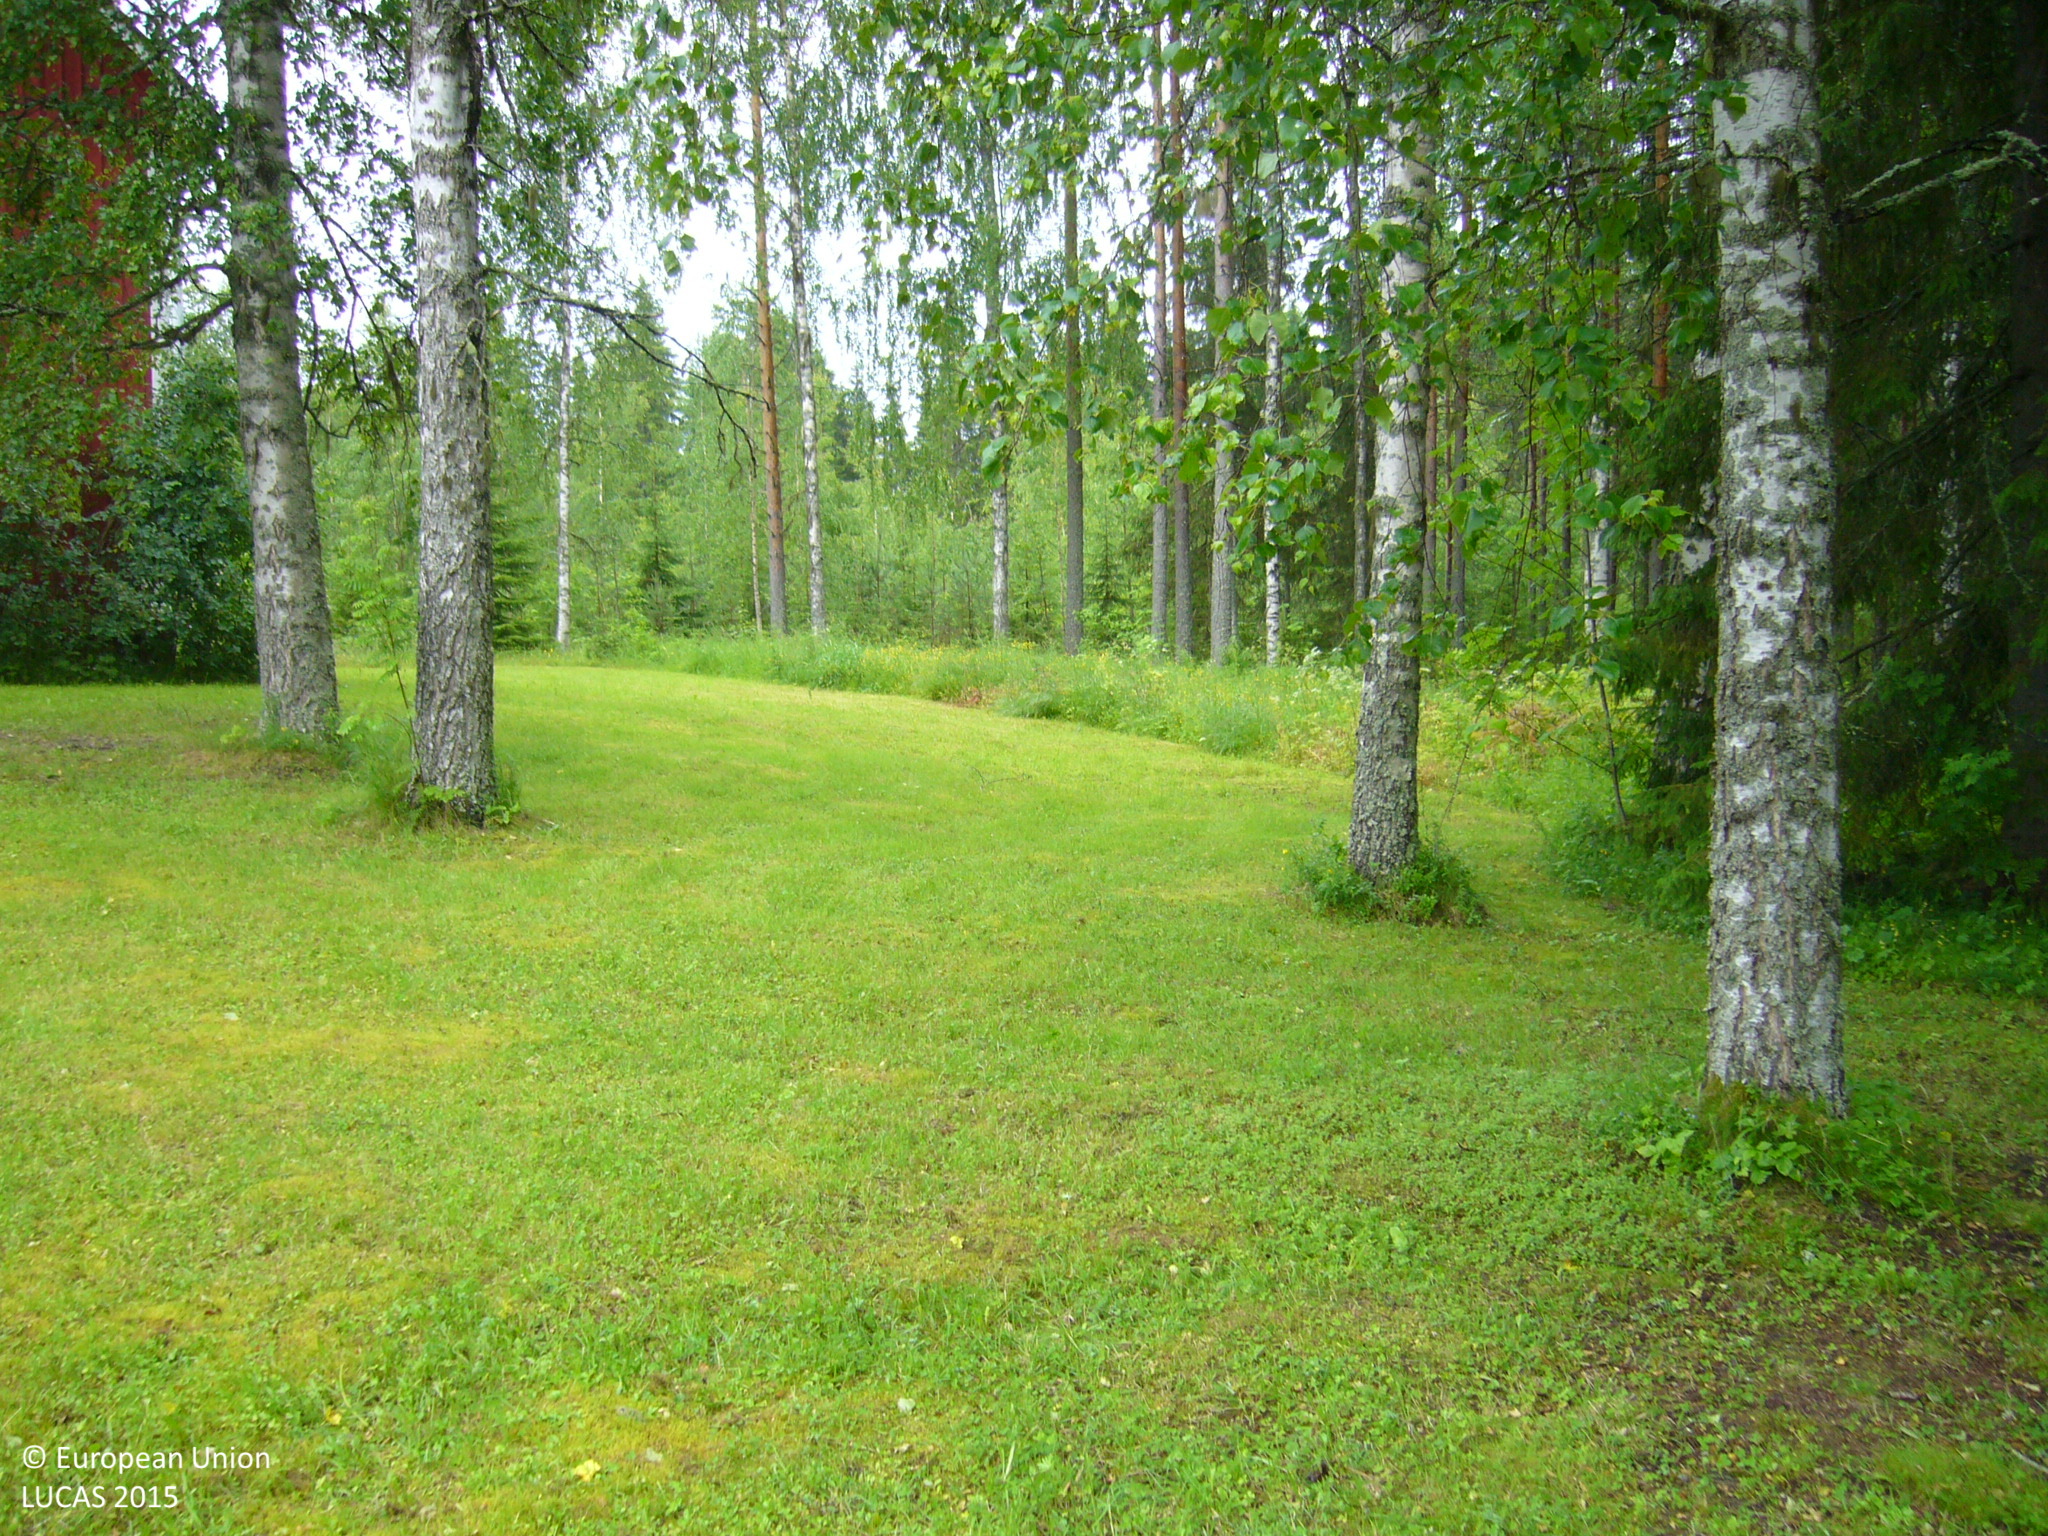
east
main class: Grassland
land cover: Grassland with sparse tree/shrub cover
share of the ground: > 75 %
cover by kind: herbaceous plants 95 %, broadleaved forest trees 5 %
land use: Community services
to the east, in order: Grassland with sparse tree/shrub cover; Spontaneously vegetated surfaces; Pine dominated mixed woodland; Electric lines; Pine dominated mixed woodland; Spruce dominated coniferous woodland; Pine dominated mixed woodland; Shruby margins; Electric lines; Shruby margins; Spruce dominated mixed woodland
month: July
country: FI
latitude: 63.4040
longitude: 25.5393
